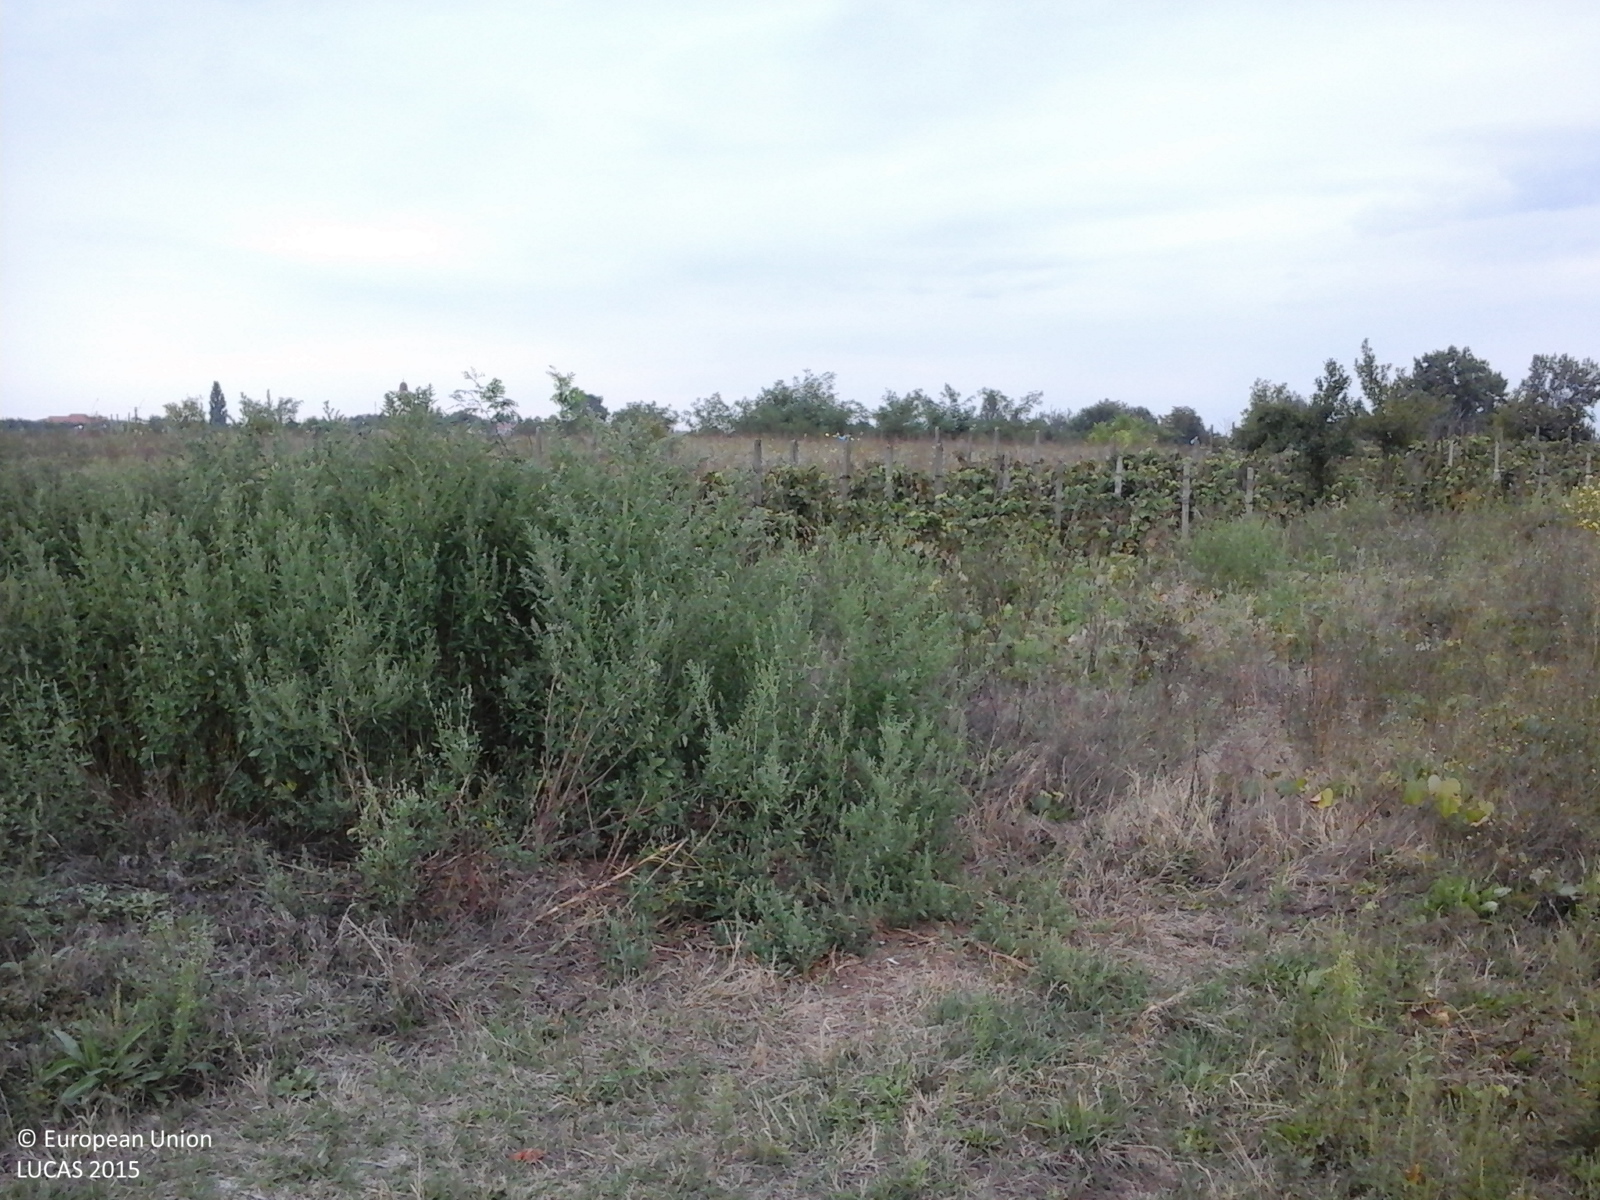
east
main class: Cropland
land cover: Vineyards
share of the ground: > 75 %
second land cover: Spontaneously vegetated surfaces
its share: > 75 %
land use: Agriculture (excluding fallow land and kitchen gardens)
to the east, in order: Vineyards; Spontaneously vegetated surfaces; Grassland with sparse tree/shrub cover; Artificial constructions in urban areas; Broadleaved woodland; Fences; Electric lines; Paved roads, cycling and walking lanes
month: September
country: RO
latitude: 47.5153
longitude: 22.1221
